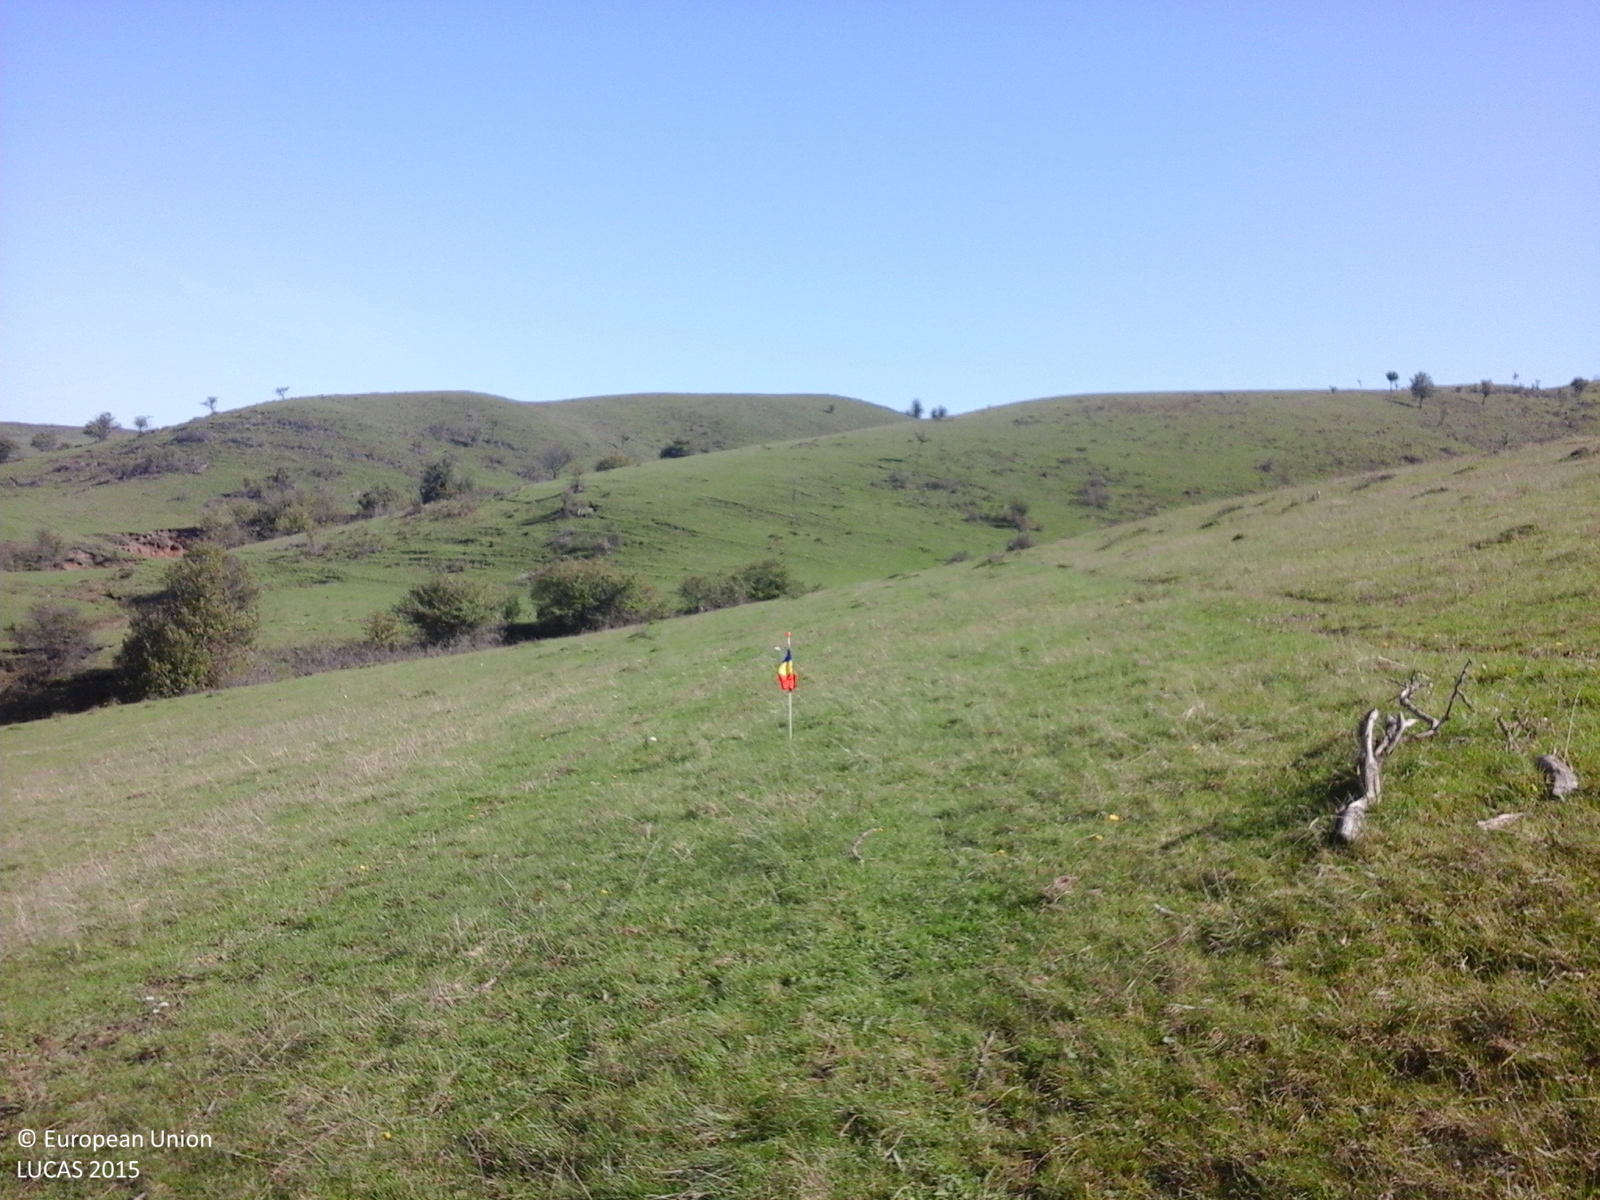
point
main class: Grassland
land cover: Grassland without tree/shrub cover
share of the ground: > 75 %
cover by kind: herbaceous plants 100 %
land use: Agriculture (excluding fallow land and kitchen gardens)
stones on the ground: < 10 %
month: October
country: RO
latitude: 46.5618
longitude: 23.5444
